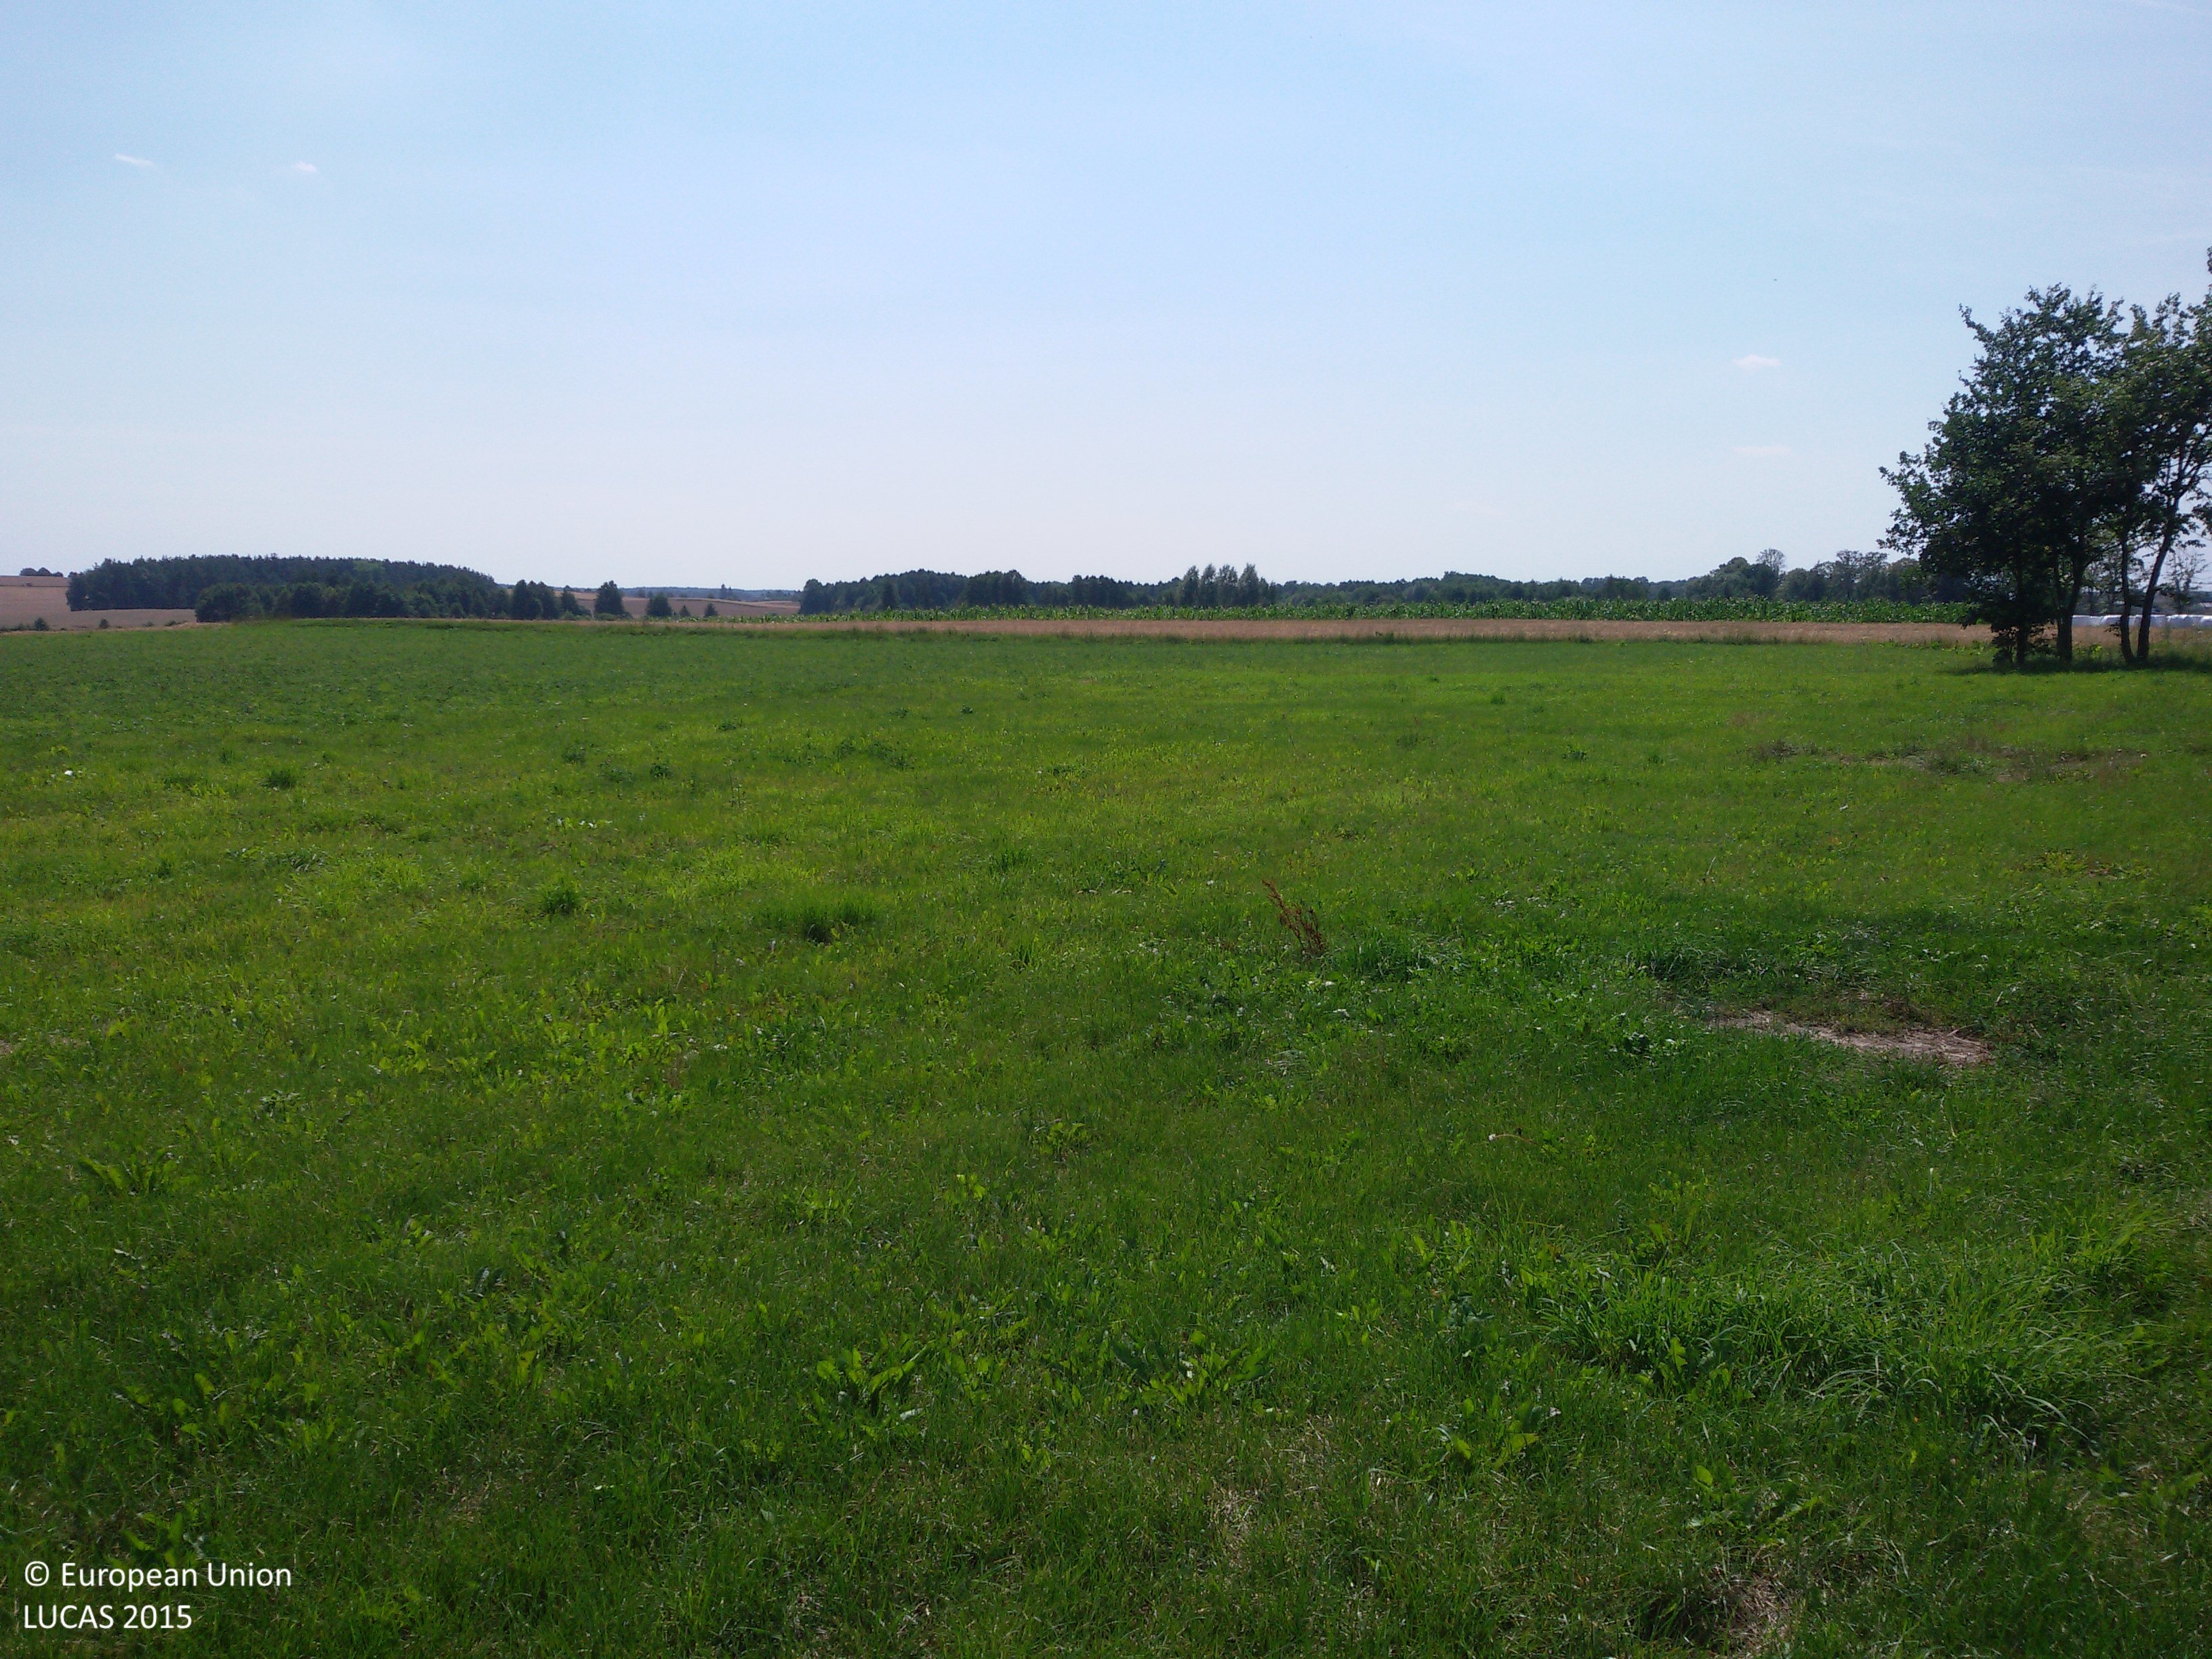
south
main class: Grassland
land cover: Grassland without tree/shrub cover
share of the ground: > 75 %
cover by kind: herbaceous plants 100 %
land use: Agriculture (excluding fallow land and kitchen gardens)
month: August
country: PL
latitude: 53.5701
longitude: 17.7293
